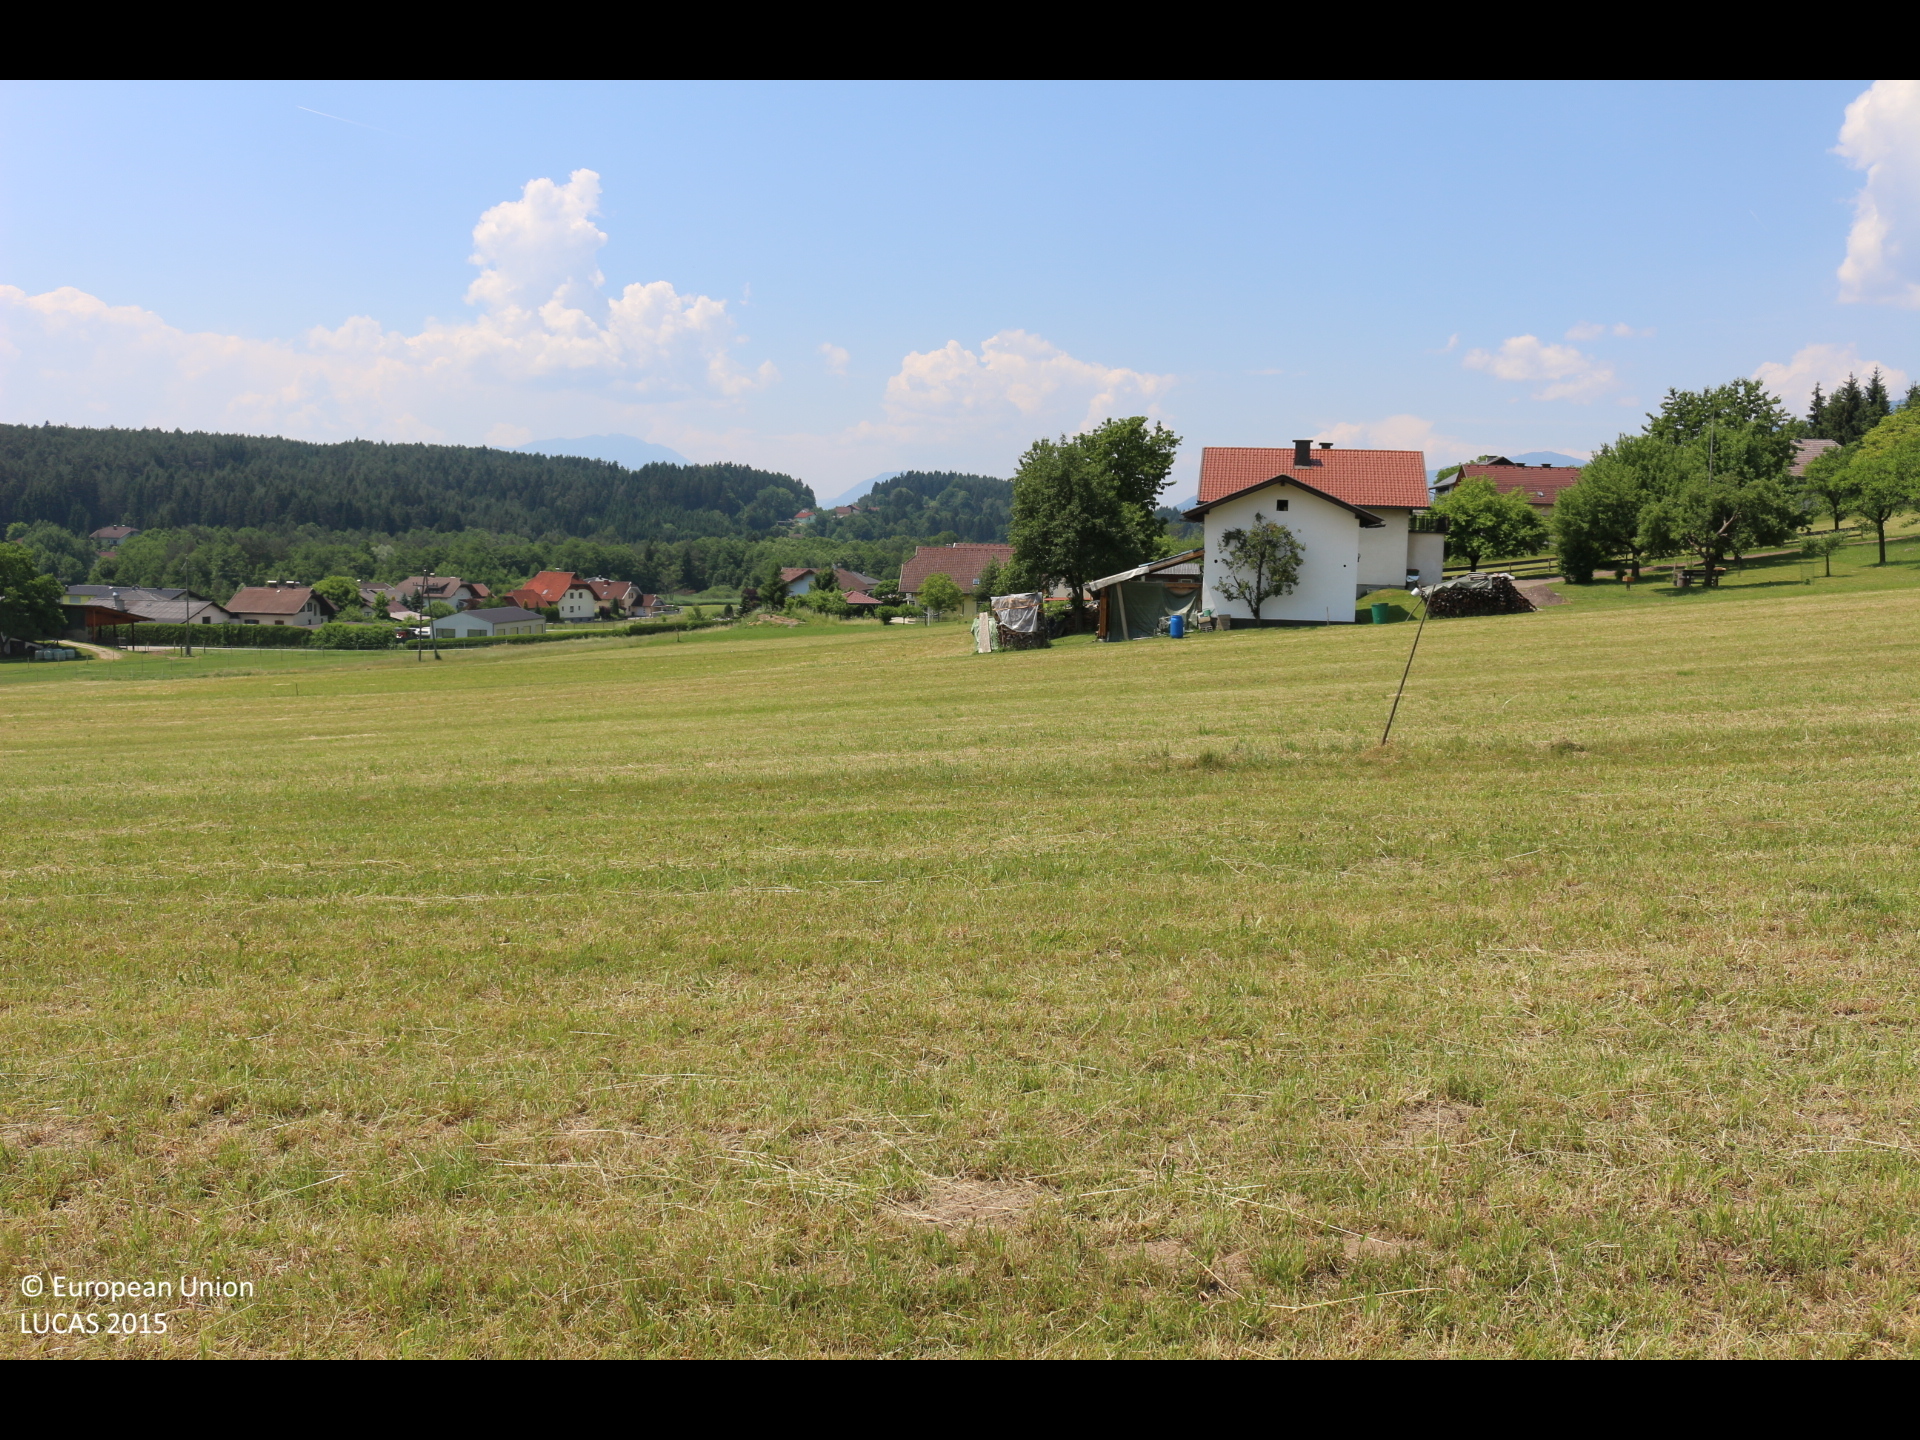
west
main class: Grassland
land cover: Grassland without tree/shrub cover
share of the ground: > 75 %
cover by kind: herbaceous plants 100 %
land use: Agriculture (excluding fallow land and kitchen gardens)
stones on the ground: < 10 %
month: June
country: AT
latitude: 46.6198
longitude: 13.9802
